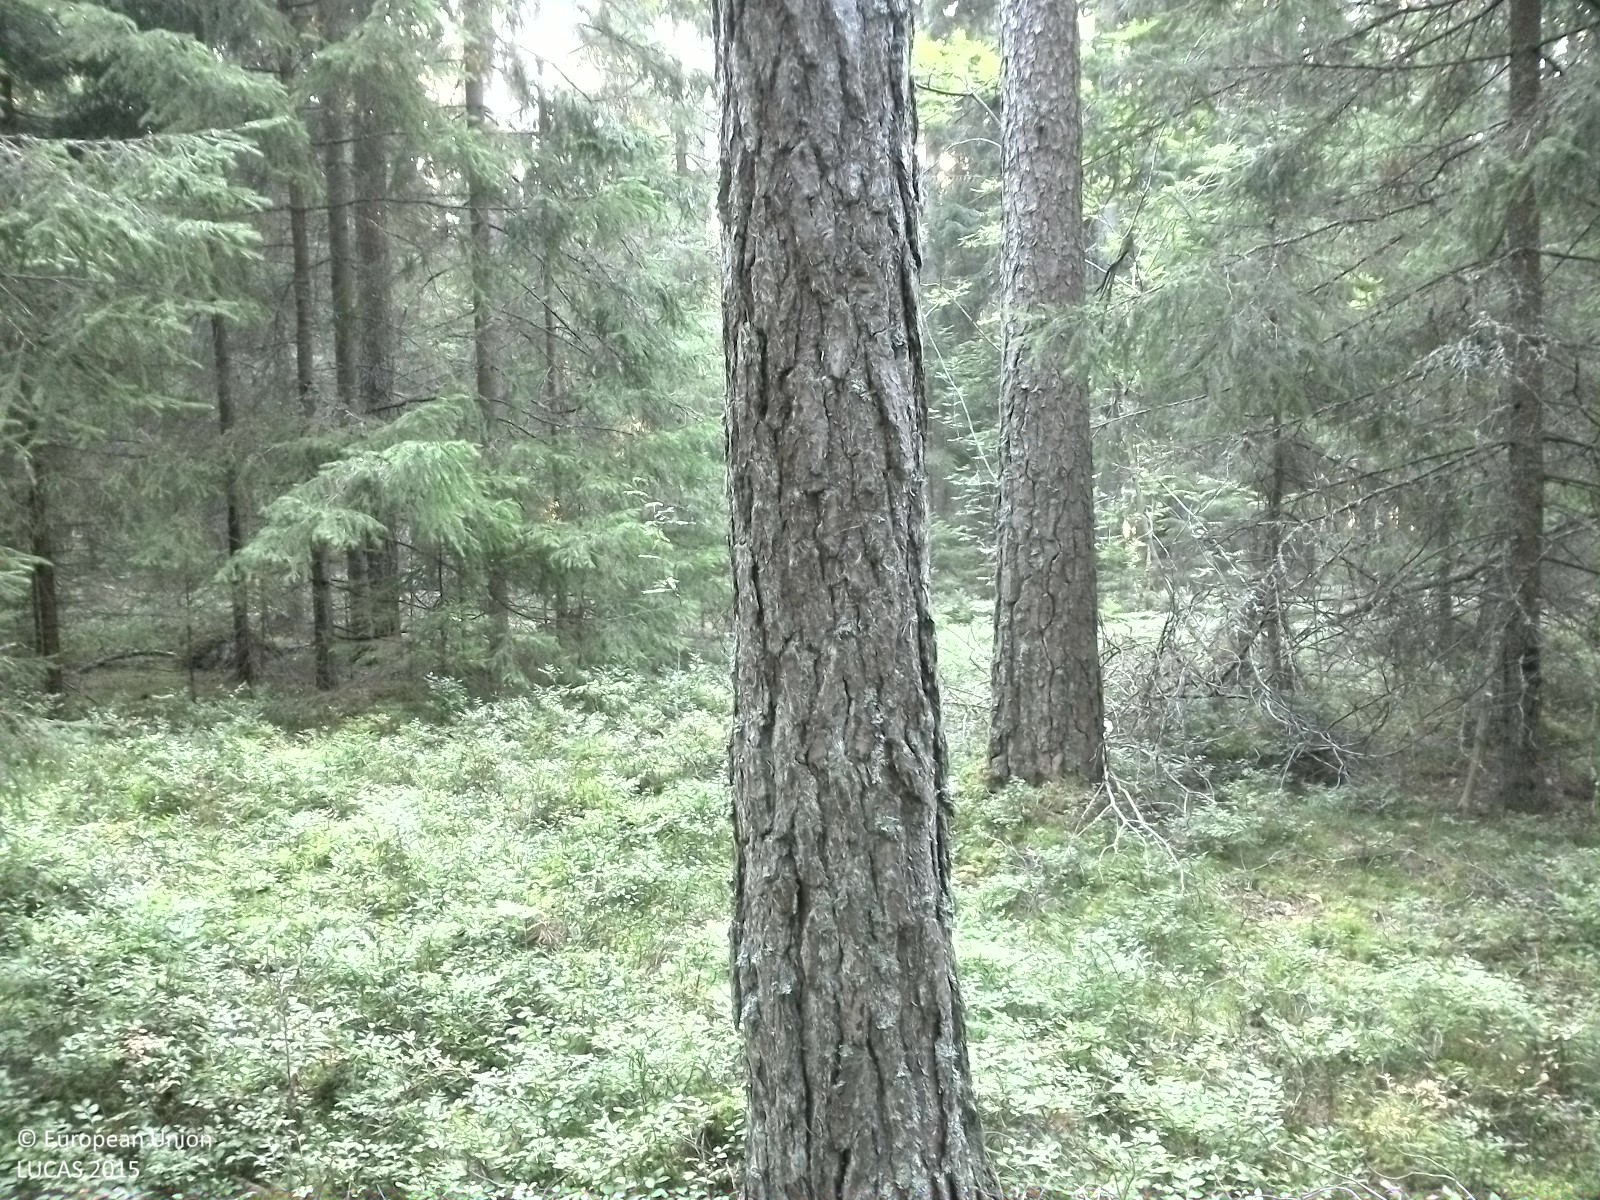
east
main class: Woodland
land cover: Other coniferous woodland
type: boreal forest
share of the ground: 25 - 50 %
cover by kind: coniferous forest trees 40 %, herbaceous plants 35 %, lichens and mosses 25 %
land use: Forestry
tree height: > 5 m
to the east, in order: Other coniferous woodland; Tracks; Other coniferous woodland; Pine dominated mixed woodland; Grass margins; Paved roads, cycling and walking lanes; Grass margins; Broadleaved woodland; Electric lines; Broadleaved woodland
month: August
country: SE
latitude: 59.3306
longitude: 15.1061
